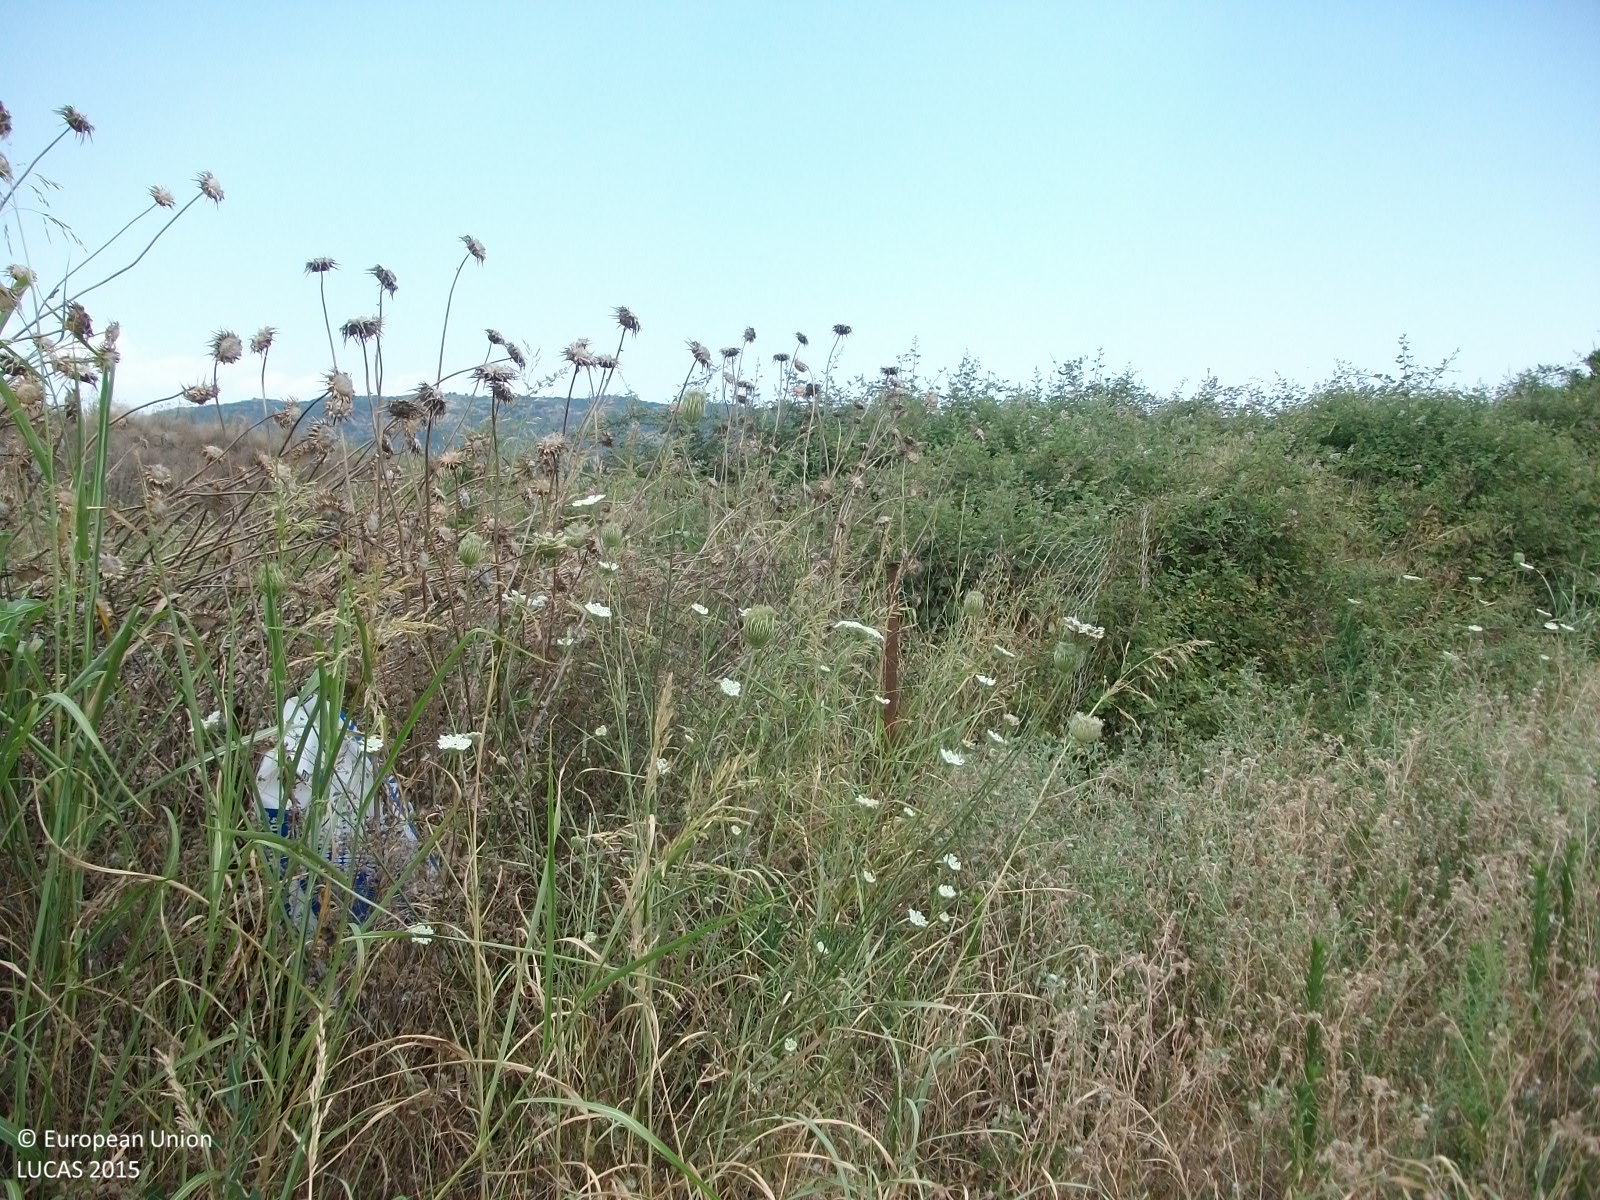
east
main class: Grassland
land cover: Spontaneously vegetated surfaces
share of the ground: > 75 %
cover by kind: herbaceous plants 95 %, shrubs 5 %
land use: Fallow land
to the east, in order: Spontaneously vegetated surfaces; Rivers and streams; Grassland without tree/shrub cover; Tracks; Grassland without tree/shrub cover; Paved roads, cycling and walking lanes; Grassland without tree/shrub cover; Olive groves; Tracks; Olive groves
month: July
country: GR
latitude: 37.0931
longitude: 22.4334
